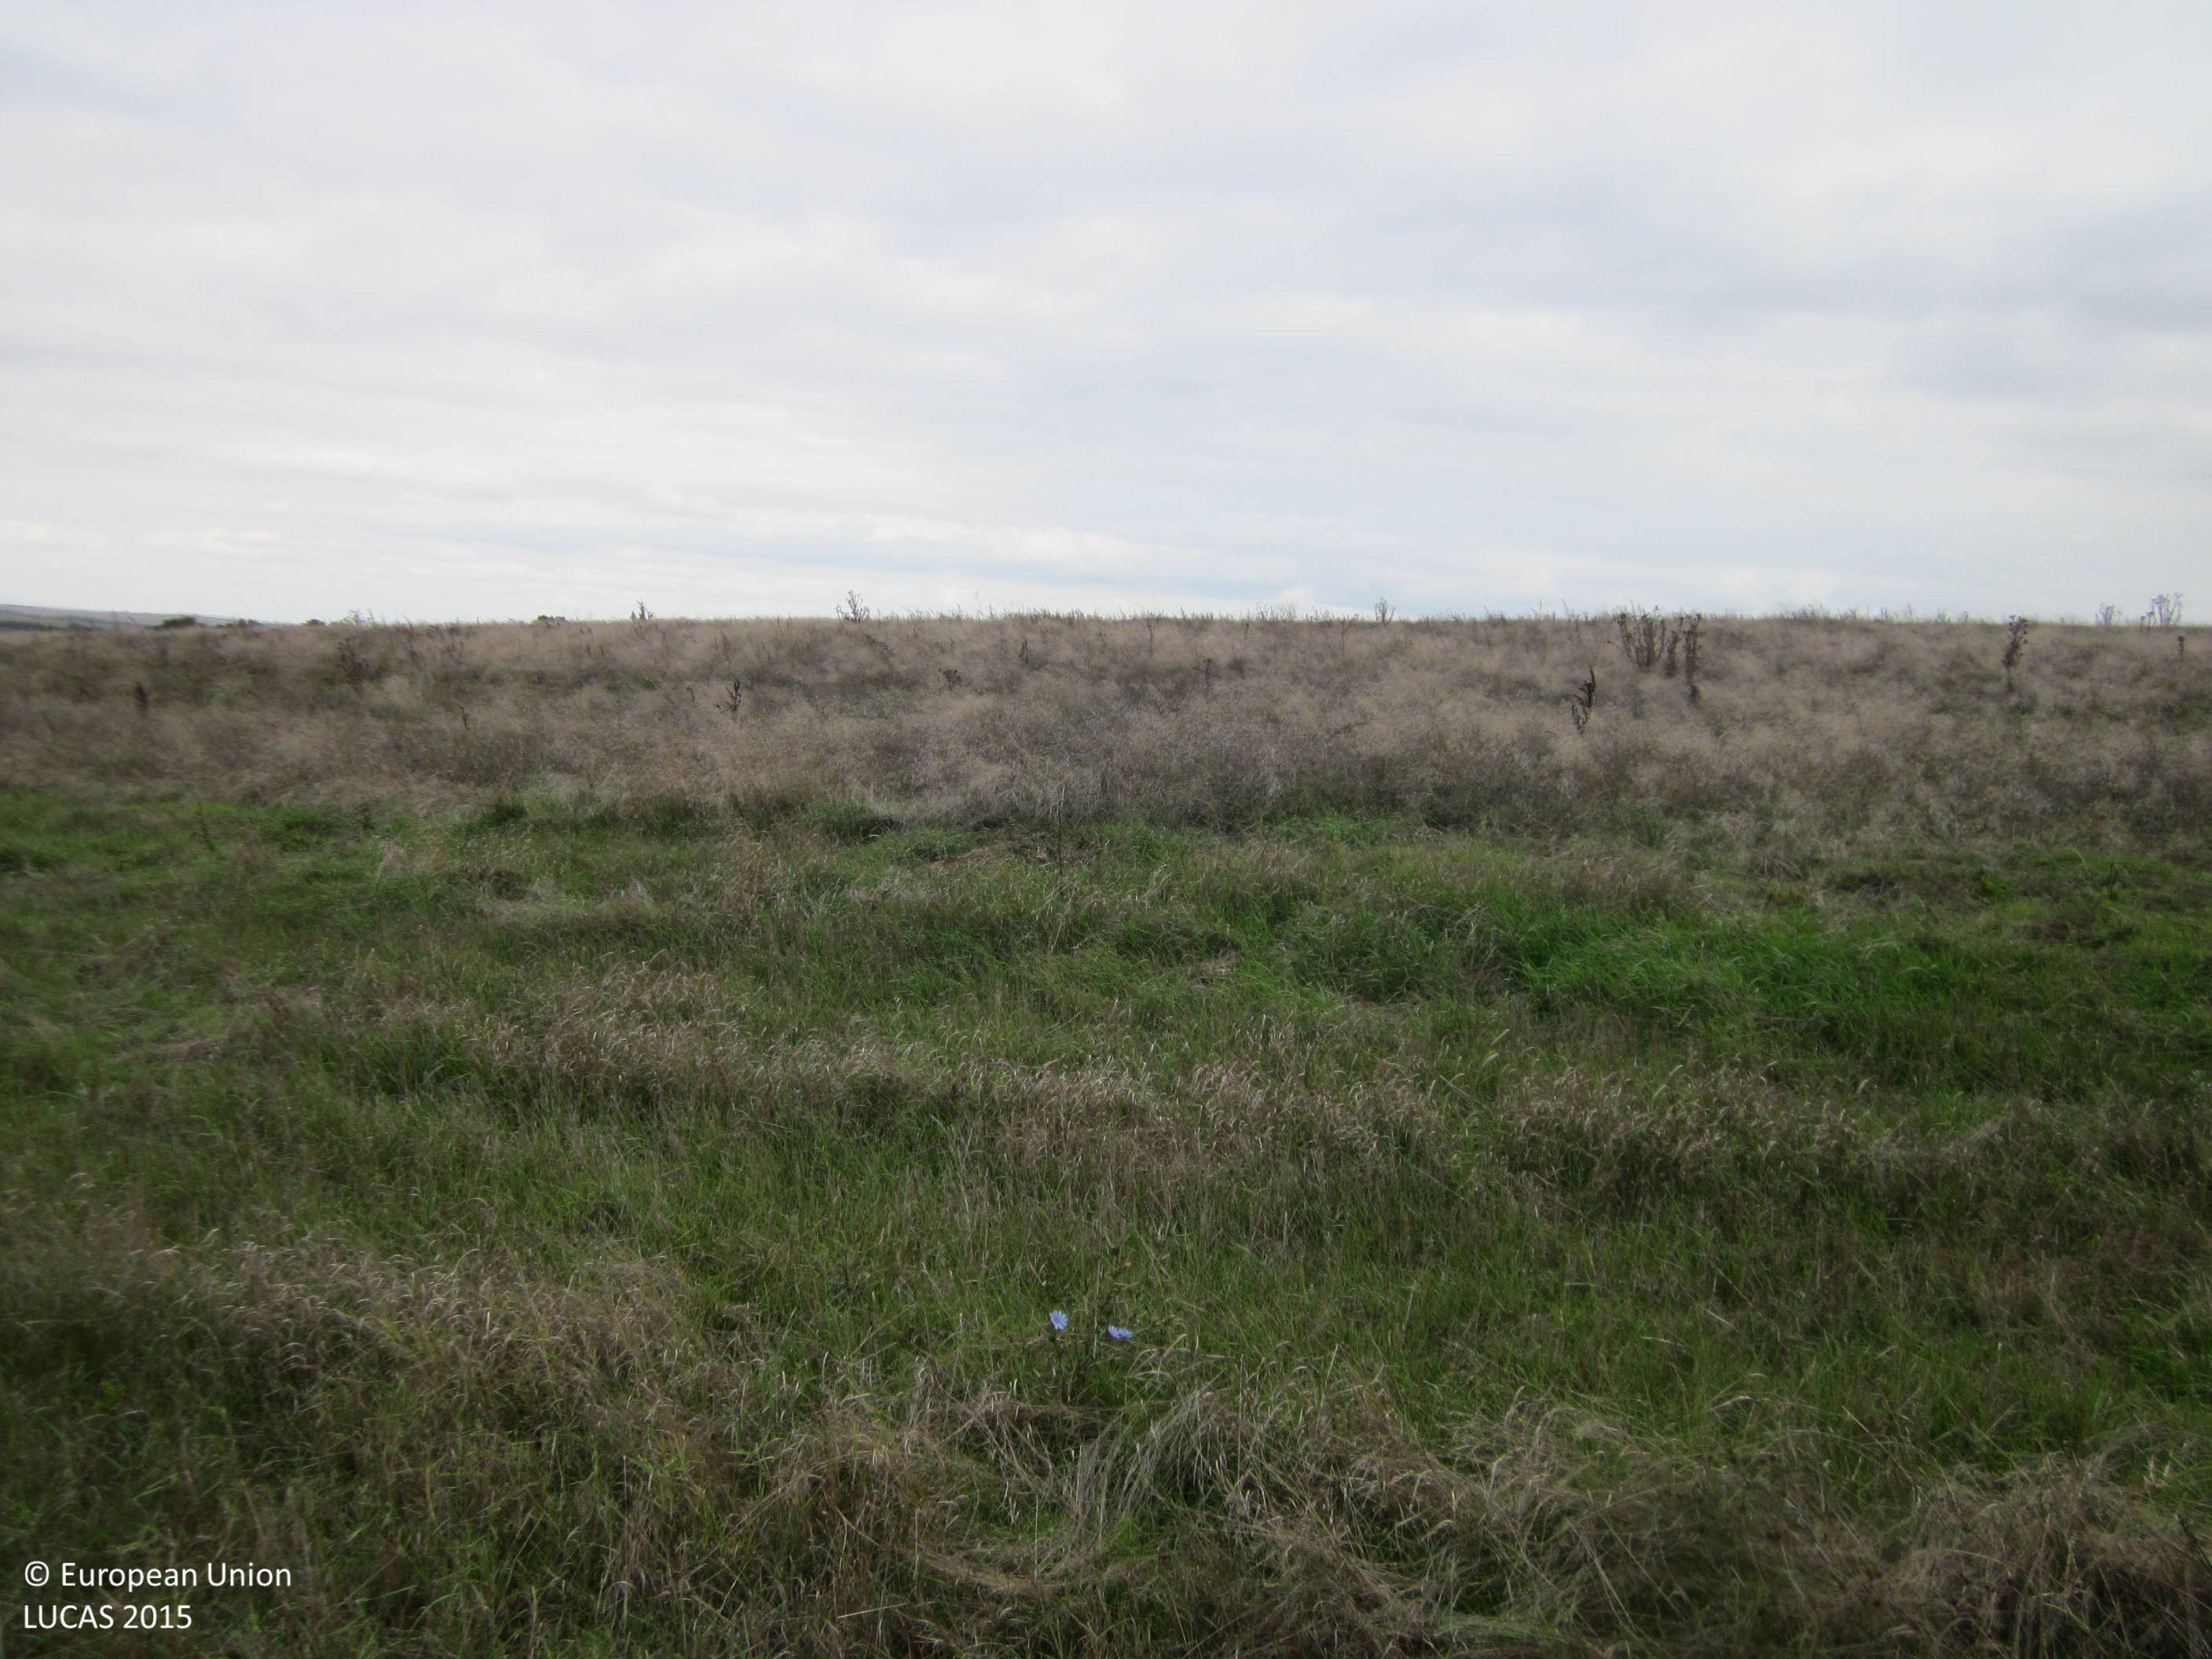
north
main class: Grassland
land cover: Grassland without tree/shrub cover
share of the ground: > 75 %
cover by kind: herbaceous plants 100 %
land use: Agriculture (excluding fallow land and kitchen gardens)
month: October
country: BG
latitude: 42.3604
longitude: 26.9167
